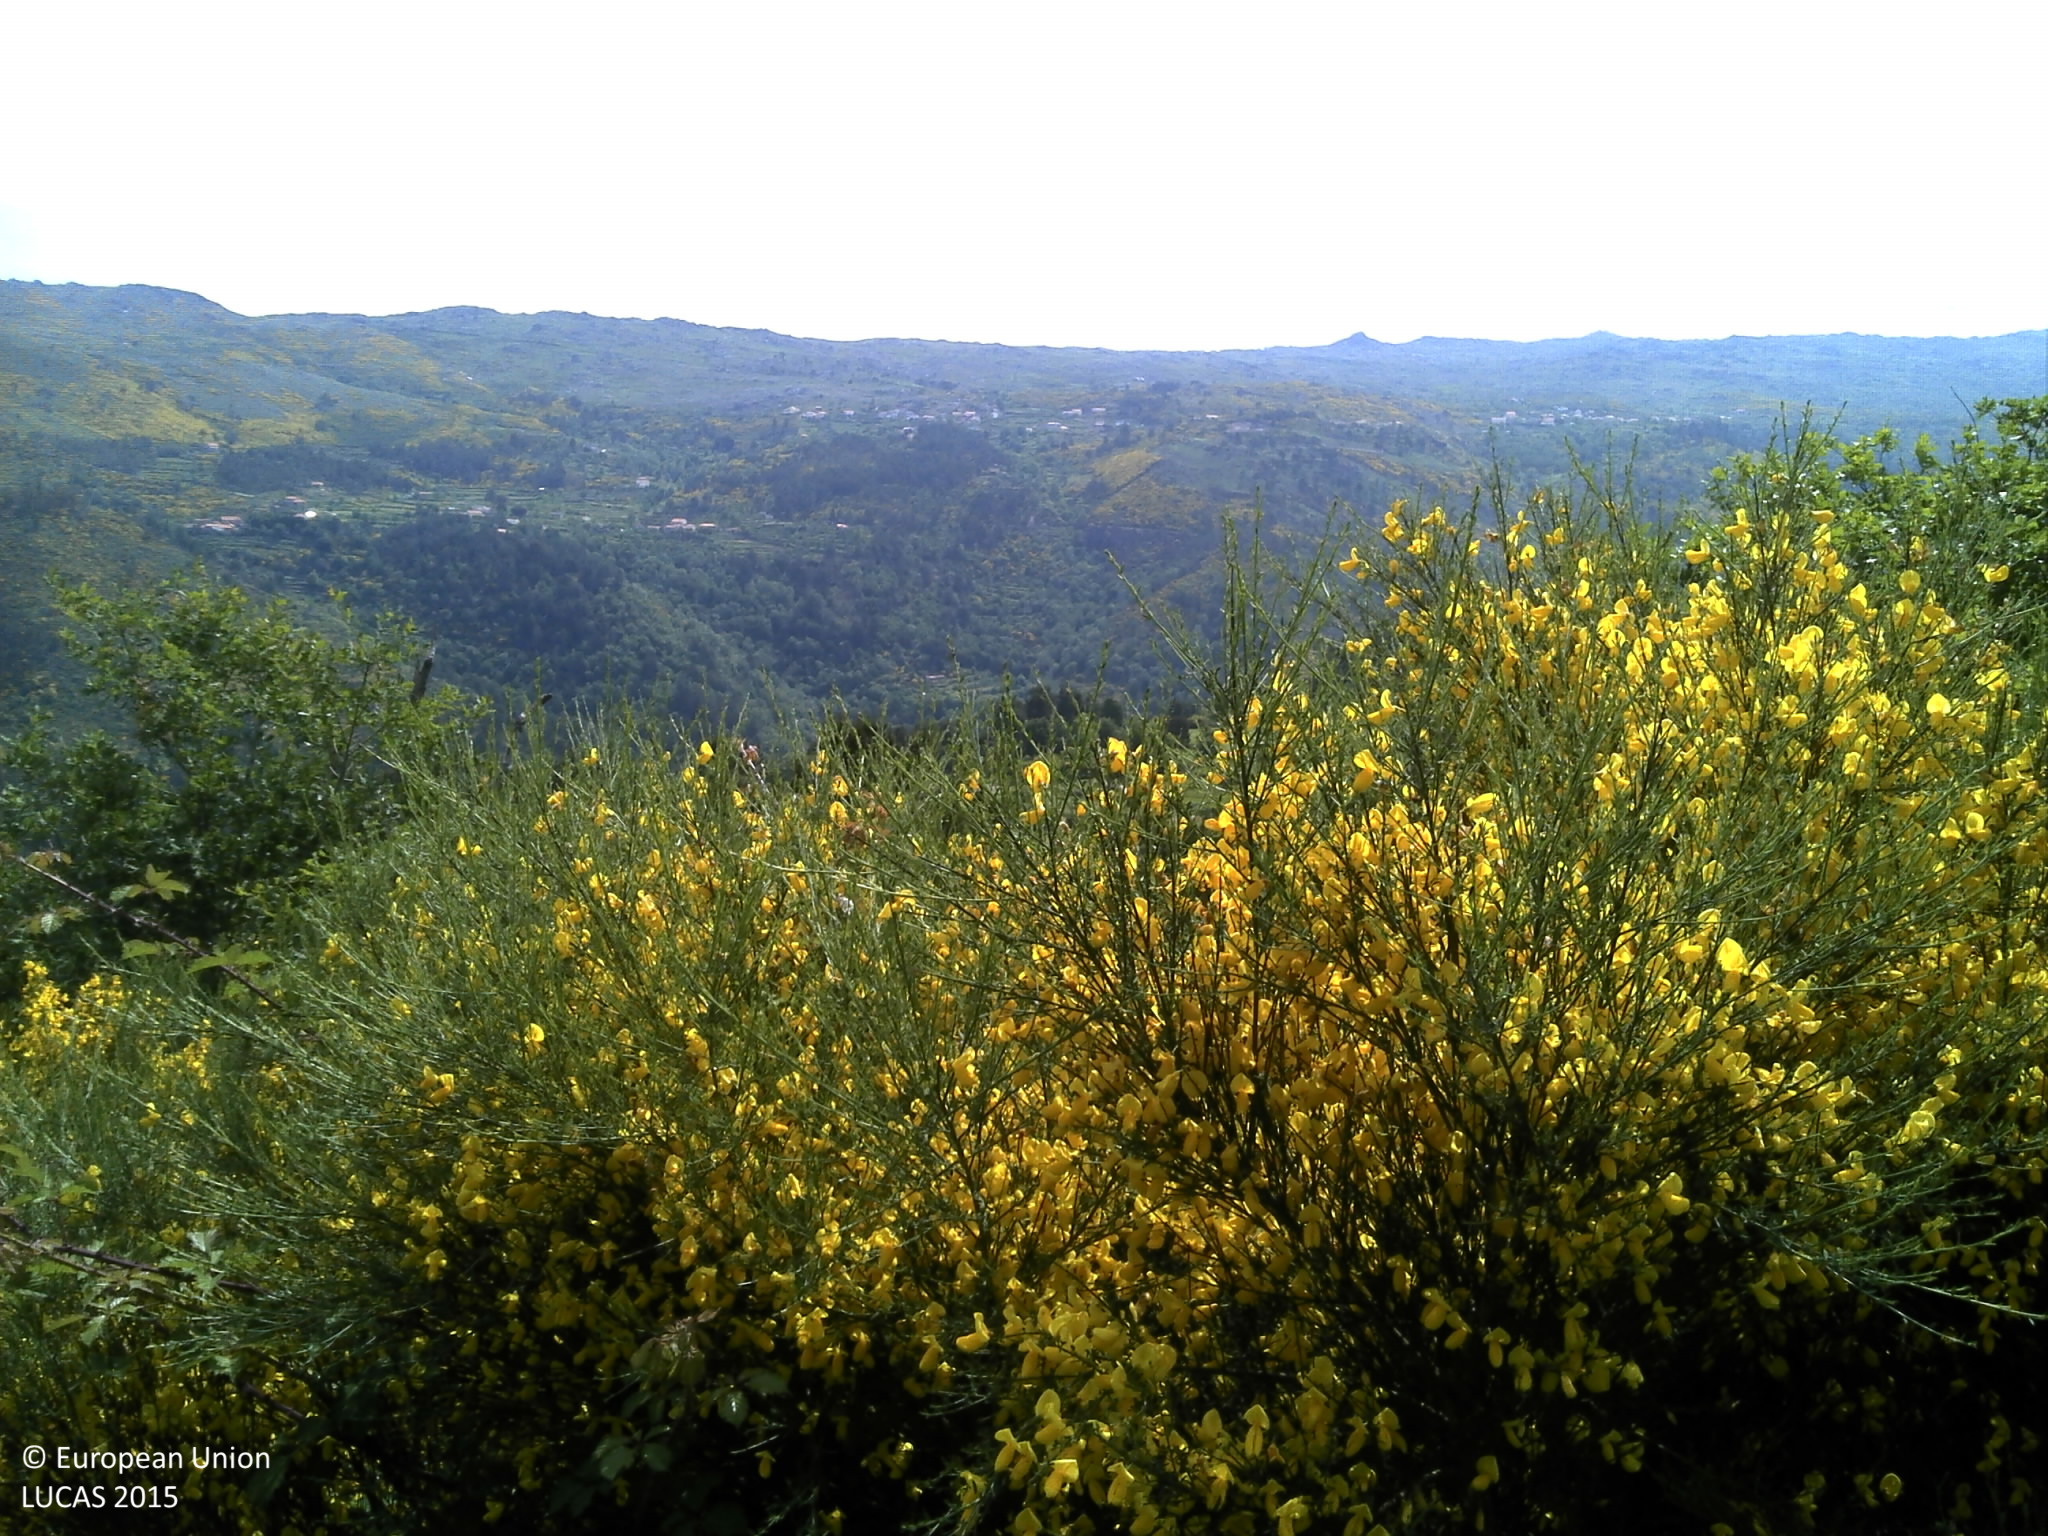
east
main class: Shrubland
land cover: Shrubland without tree cover
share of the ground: 50 - 75 %
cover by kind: shrubs 75 %, herbaceous plants 10 %, consolidated bare surface 10 %, unconsolidated bare surface 5 %
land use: Abandoned areas
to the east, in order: Shrubland without tree cover; Shrubland with sparse tree cover; Dry stone walls; Shrubland without tree cover; Shrubland with sparse tree cover; Electric lines; Shrubland without tree cover; Broadleaved woodland
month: May
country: PT
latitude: 41.0331
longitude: -8.0597
